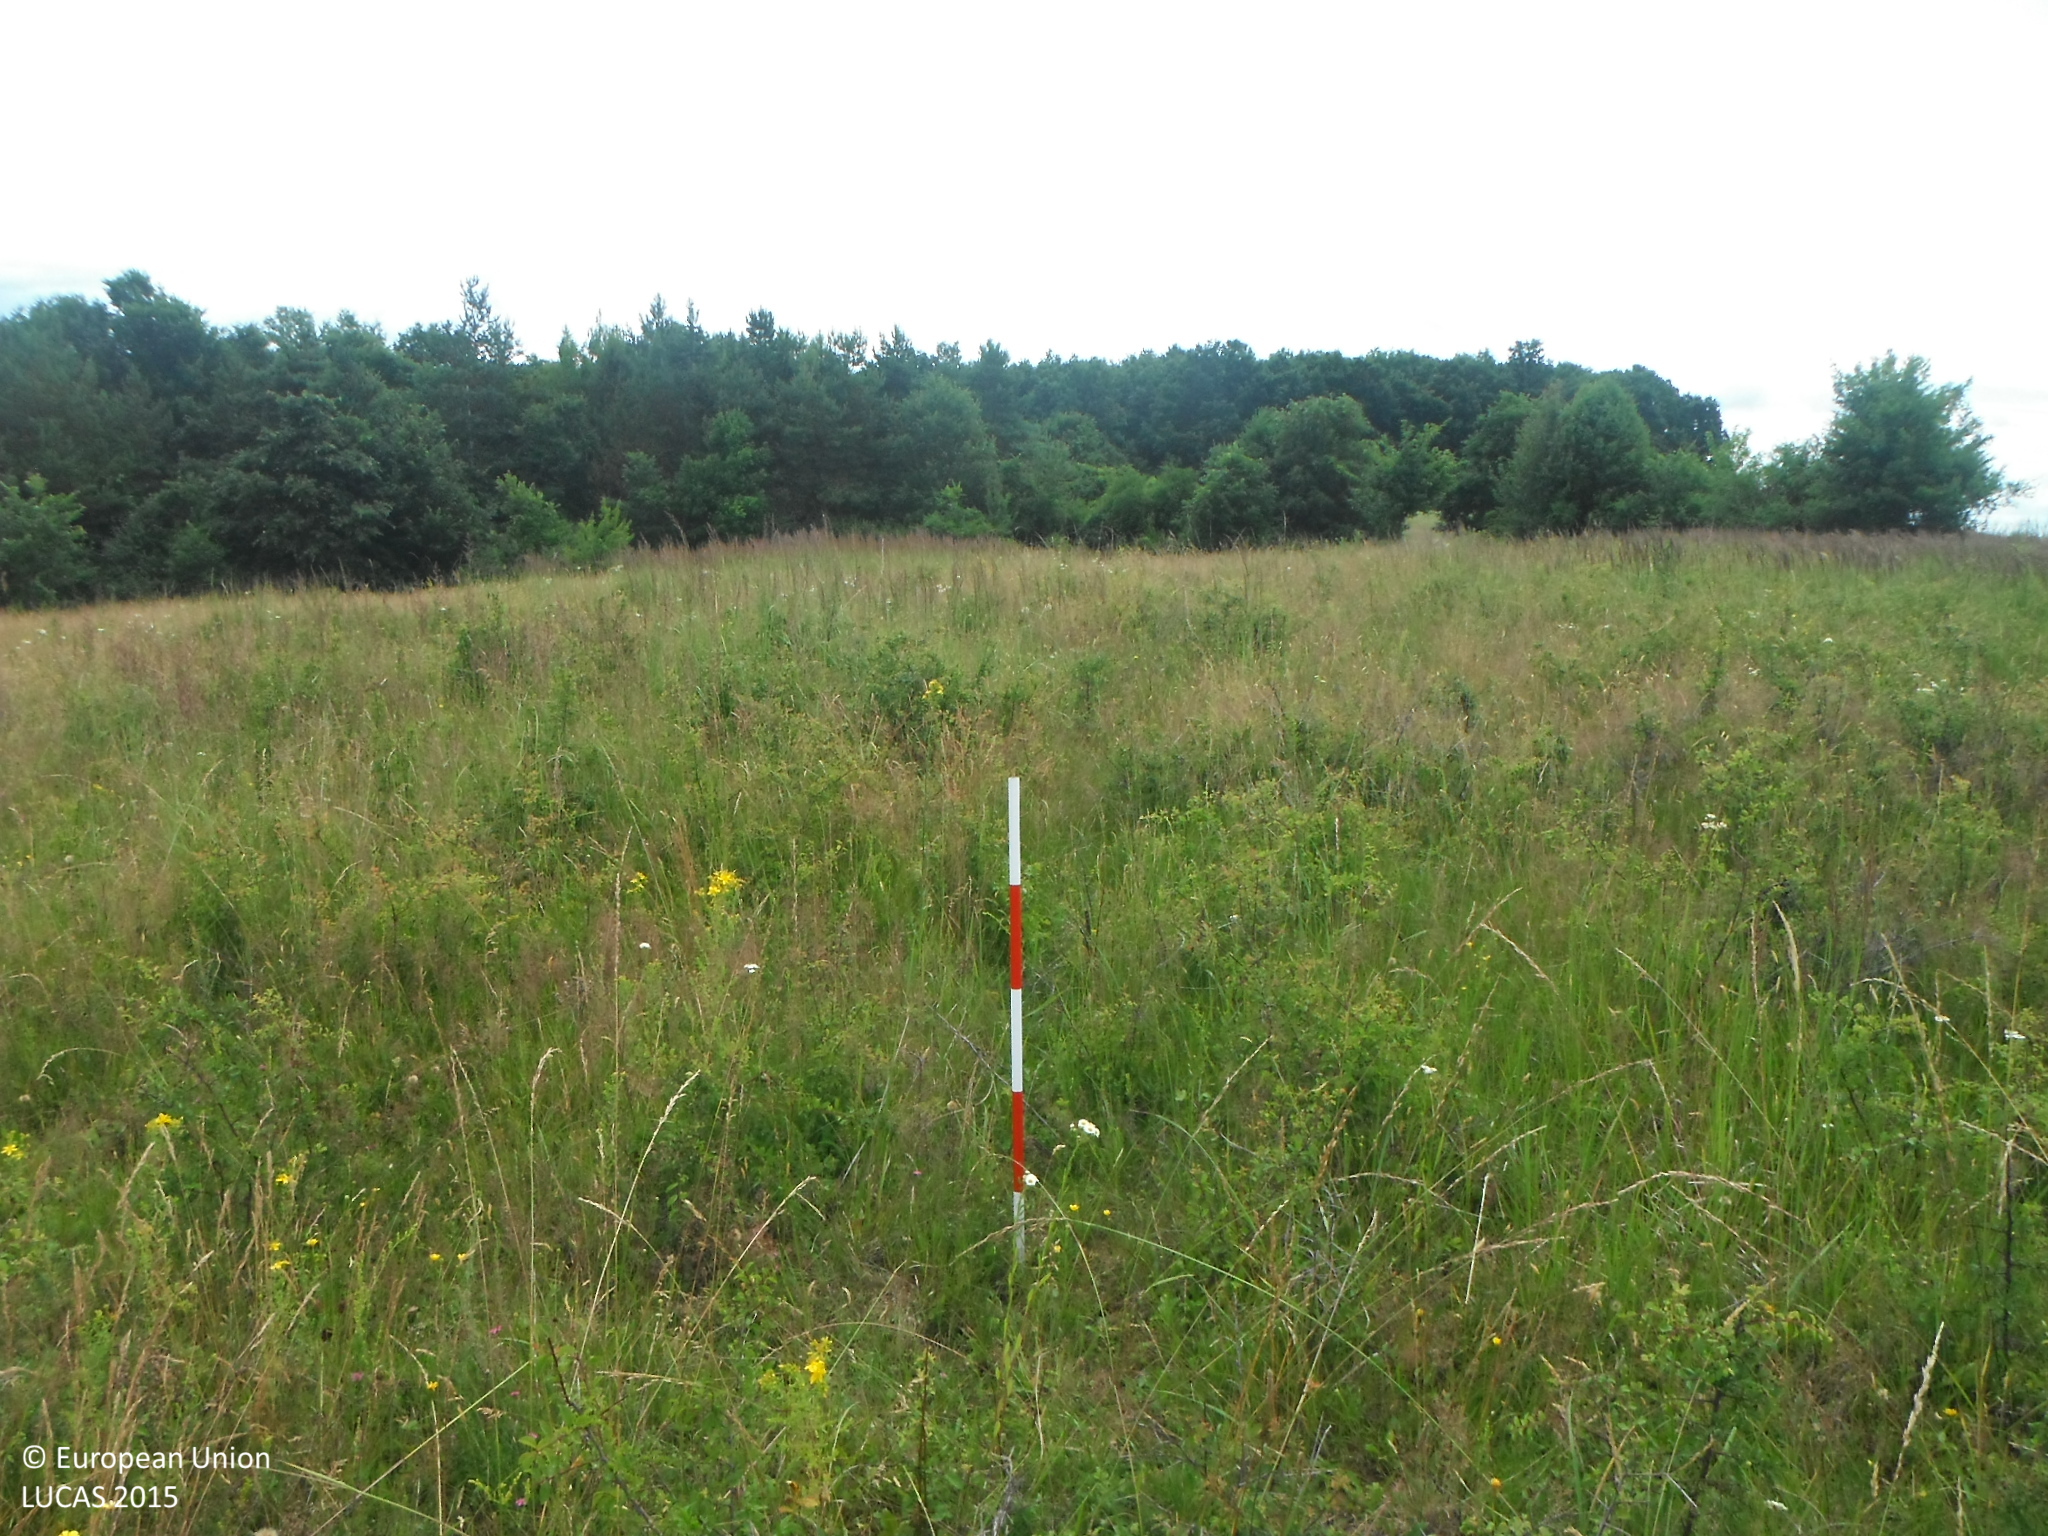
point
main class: Grassland
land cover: Grassland with sparse tree/shrub cover
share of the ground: > 75 %
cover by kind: herbaceous plants 90 %, broadleaved forest trees 5 %, shrubs 5 %
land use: Semi-natural and natural areas not in use
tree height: < 5 m
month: June
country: SK
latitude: 48.5086
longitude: 20.2245
